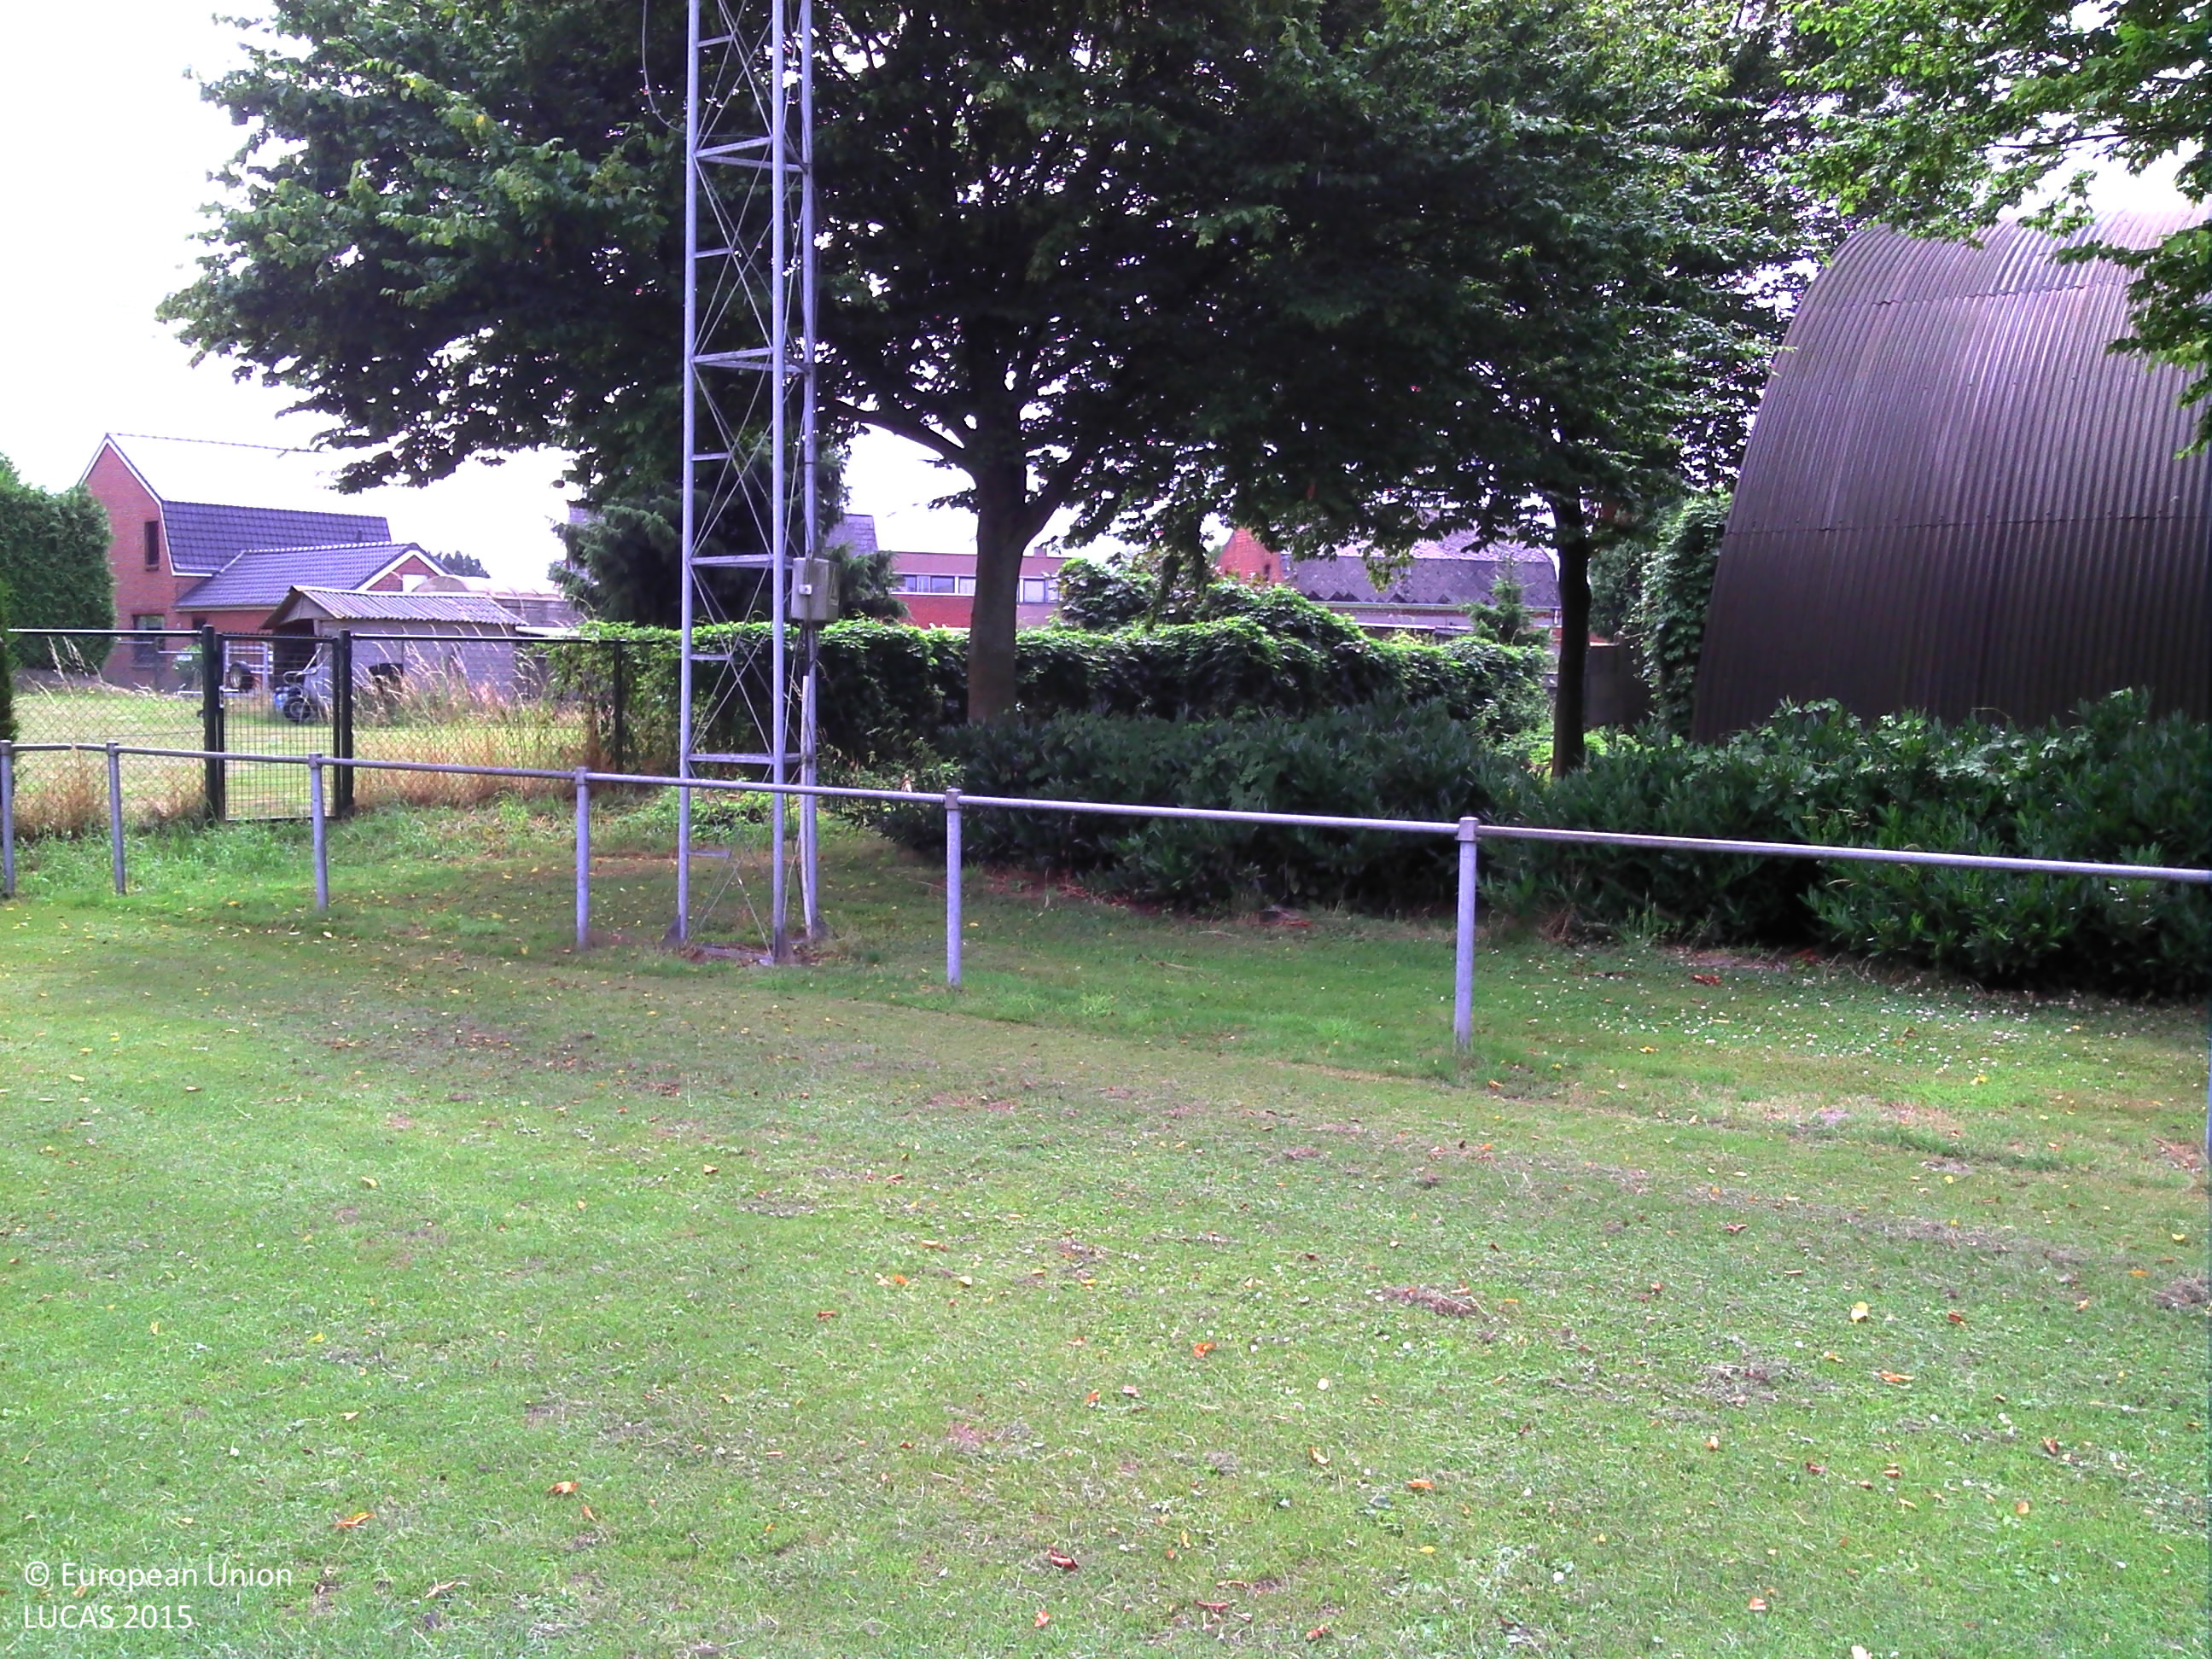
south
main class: Grassland
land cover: Grassland without tree/shrub cover
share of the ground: > 75 %
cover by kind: herbaceous plants 100 %
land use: Sport
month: July
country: BE
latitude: 51.2485
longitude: 5.5140
